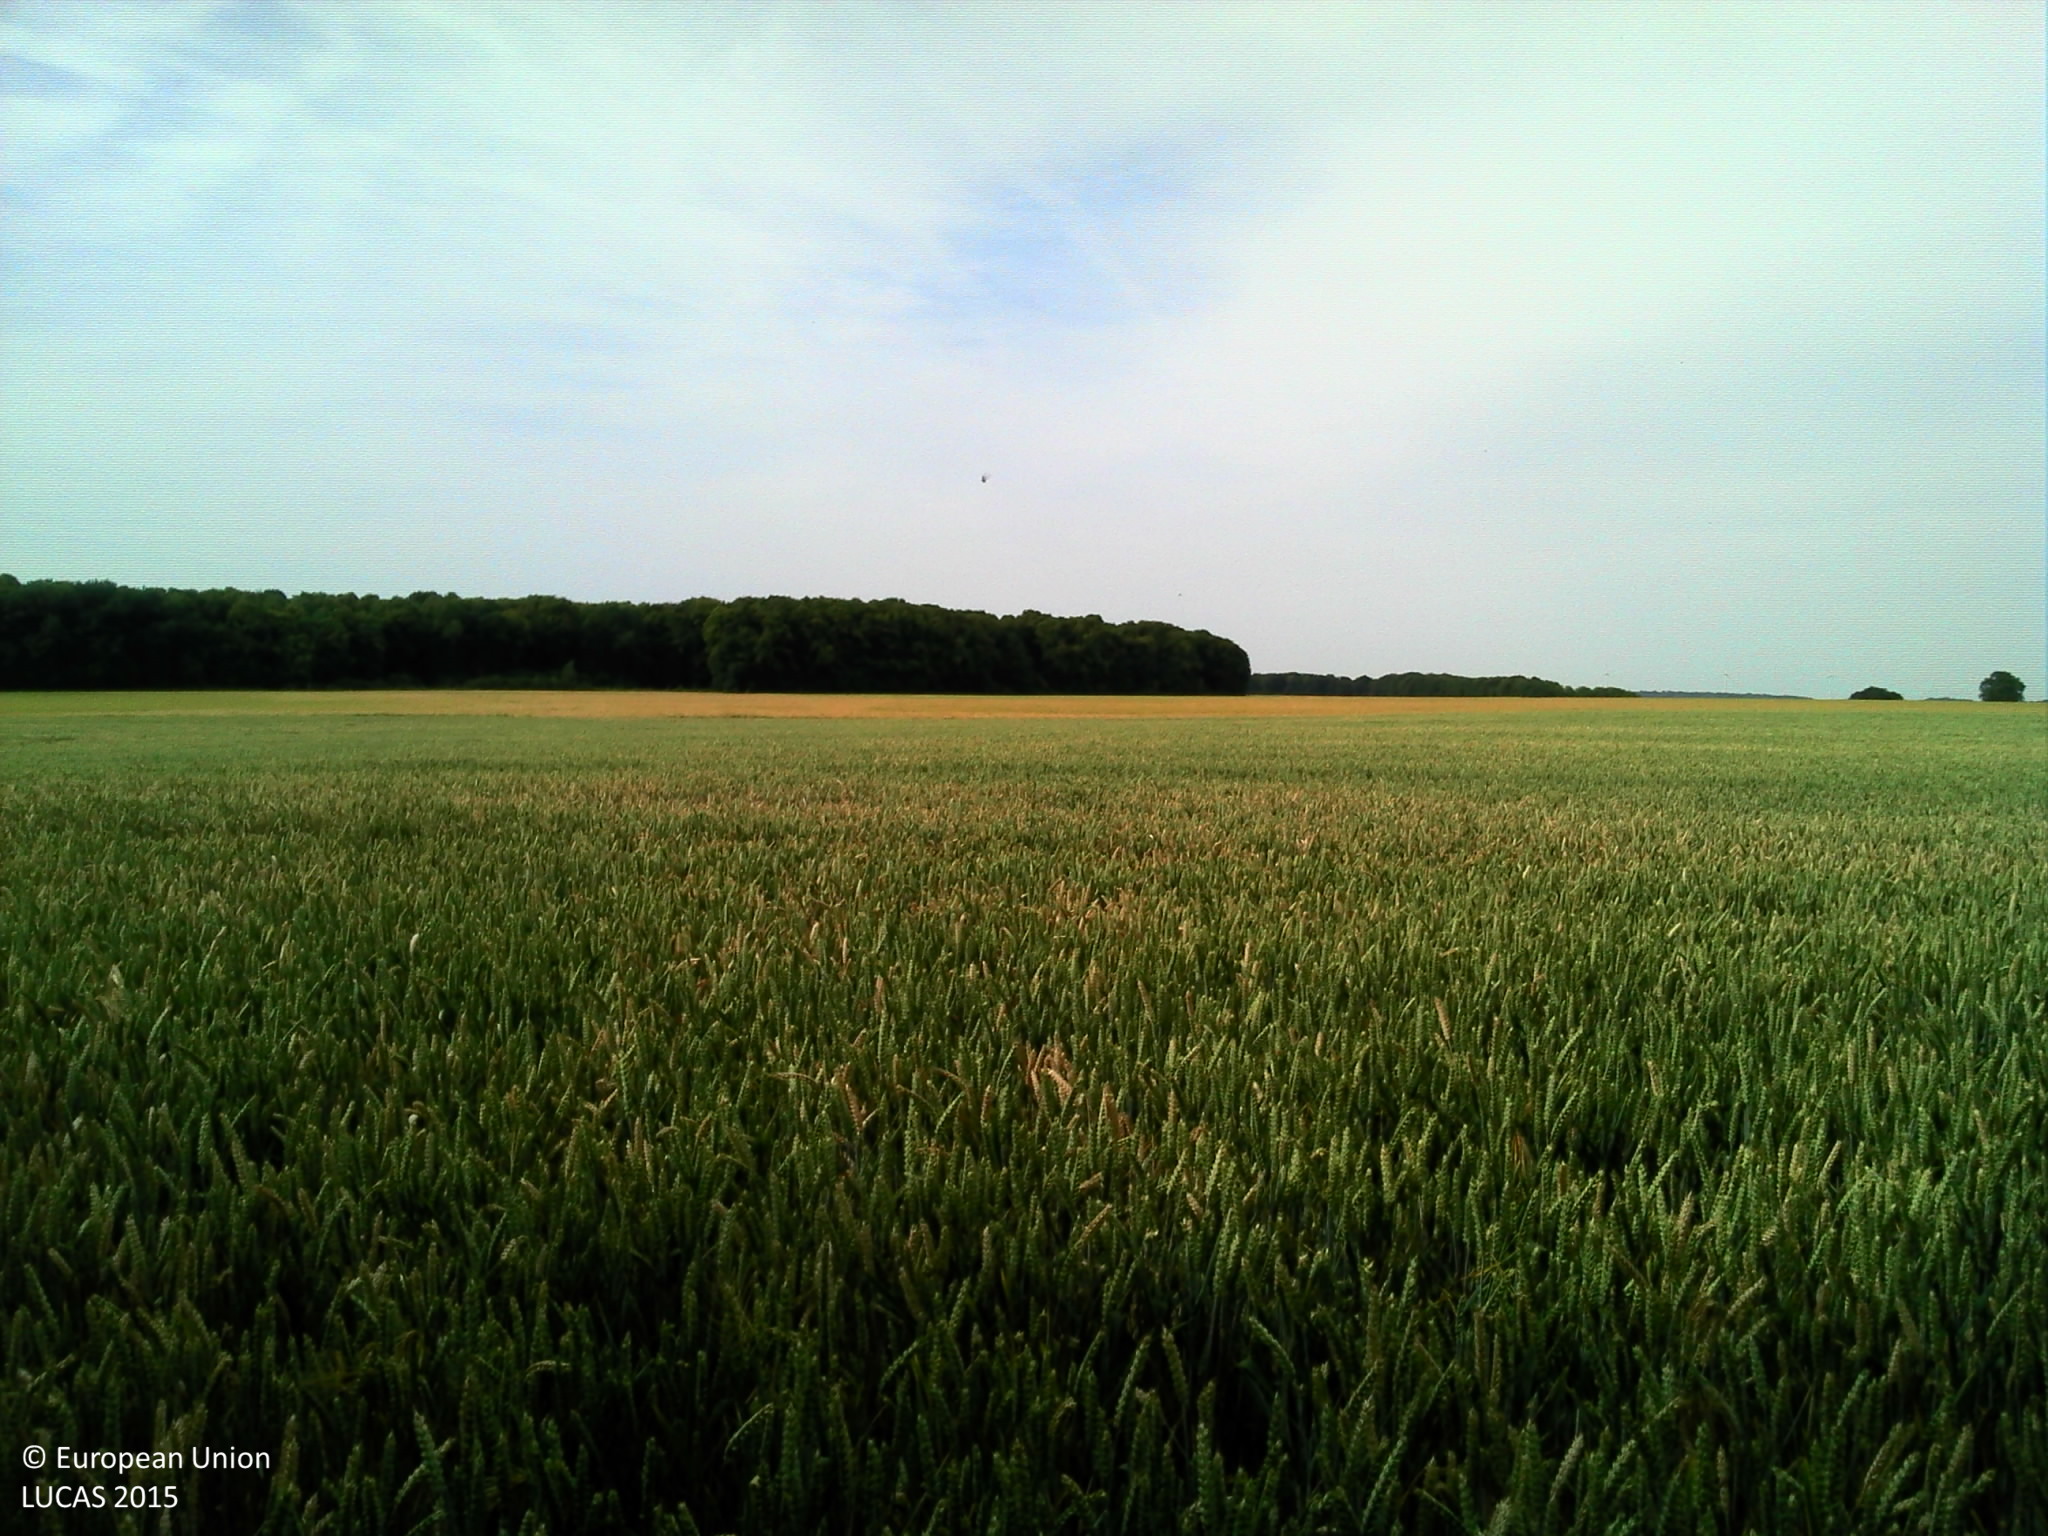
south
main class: Cropland
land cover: Common wheat
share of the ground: > 75 %
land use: Agriculture (excluding fallow land and kitchen gardens)
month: June
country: FR
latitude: 49.6243
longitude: 2.4152
